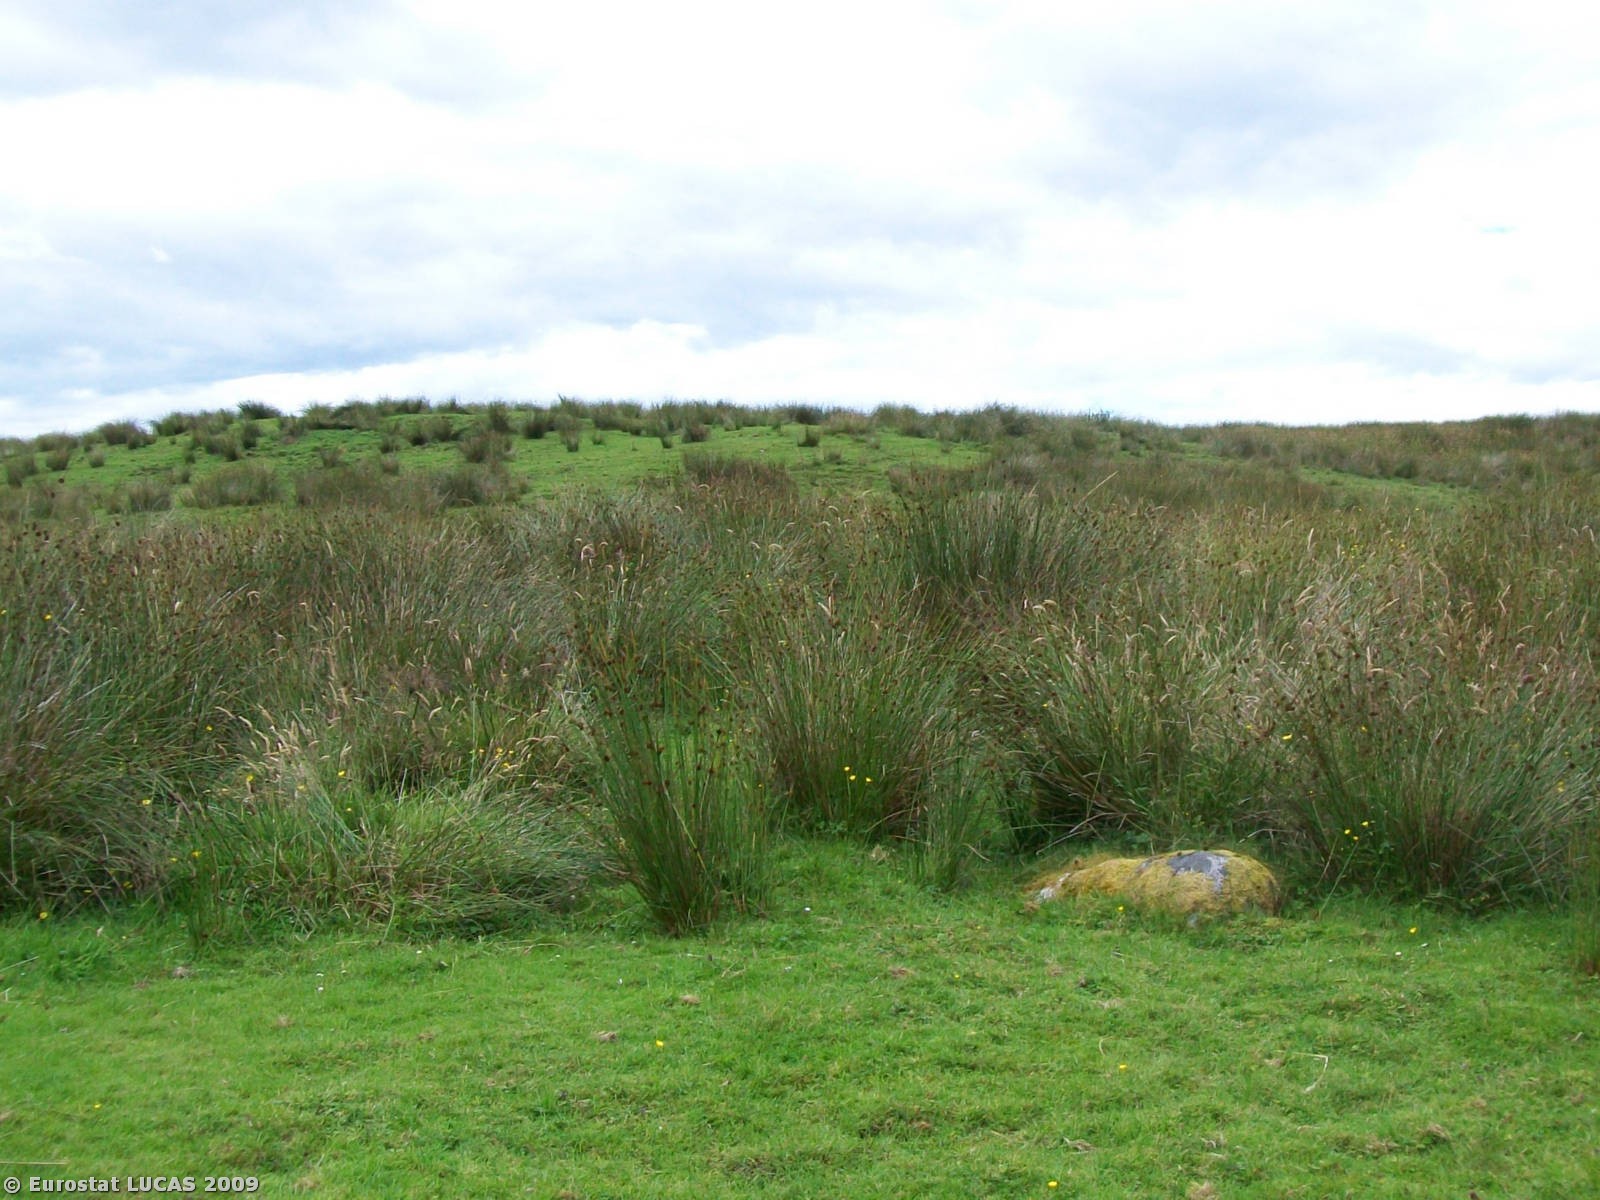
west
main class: Grassland
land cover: Grassland without tree/shrub cover
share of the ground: > 75 %
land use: Agriculture (excluding fallow land and kitchen gardens)
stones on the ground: 10 - 25 %
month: July
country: GB
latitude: 56.4250
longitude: -5.2409
